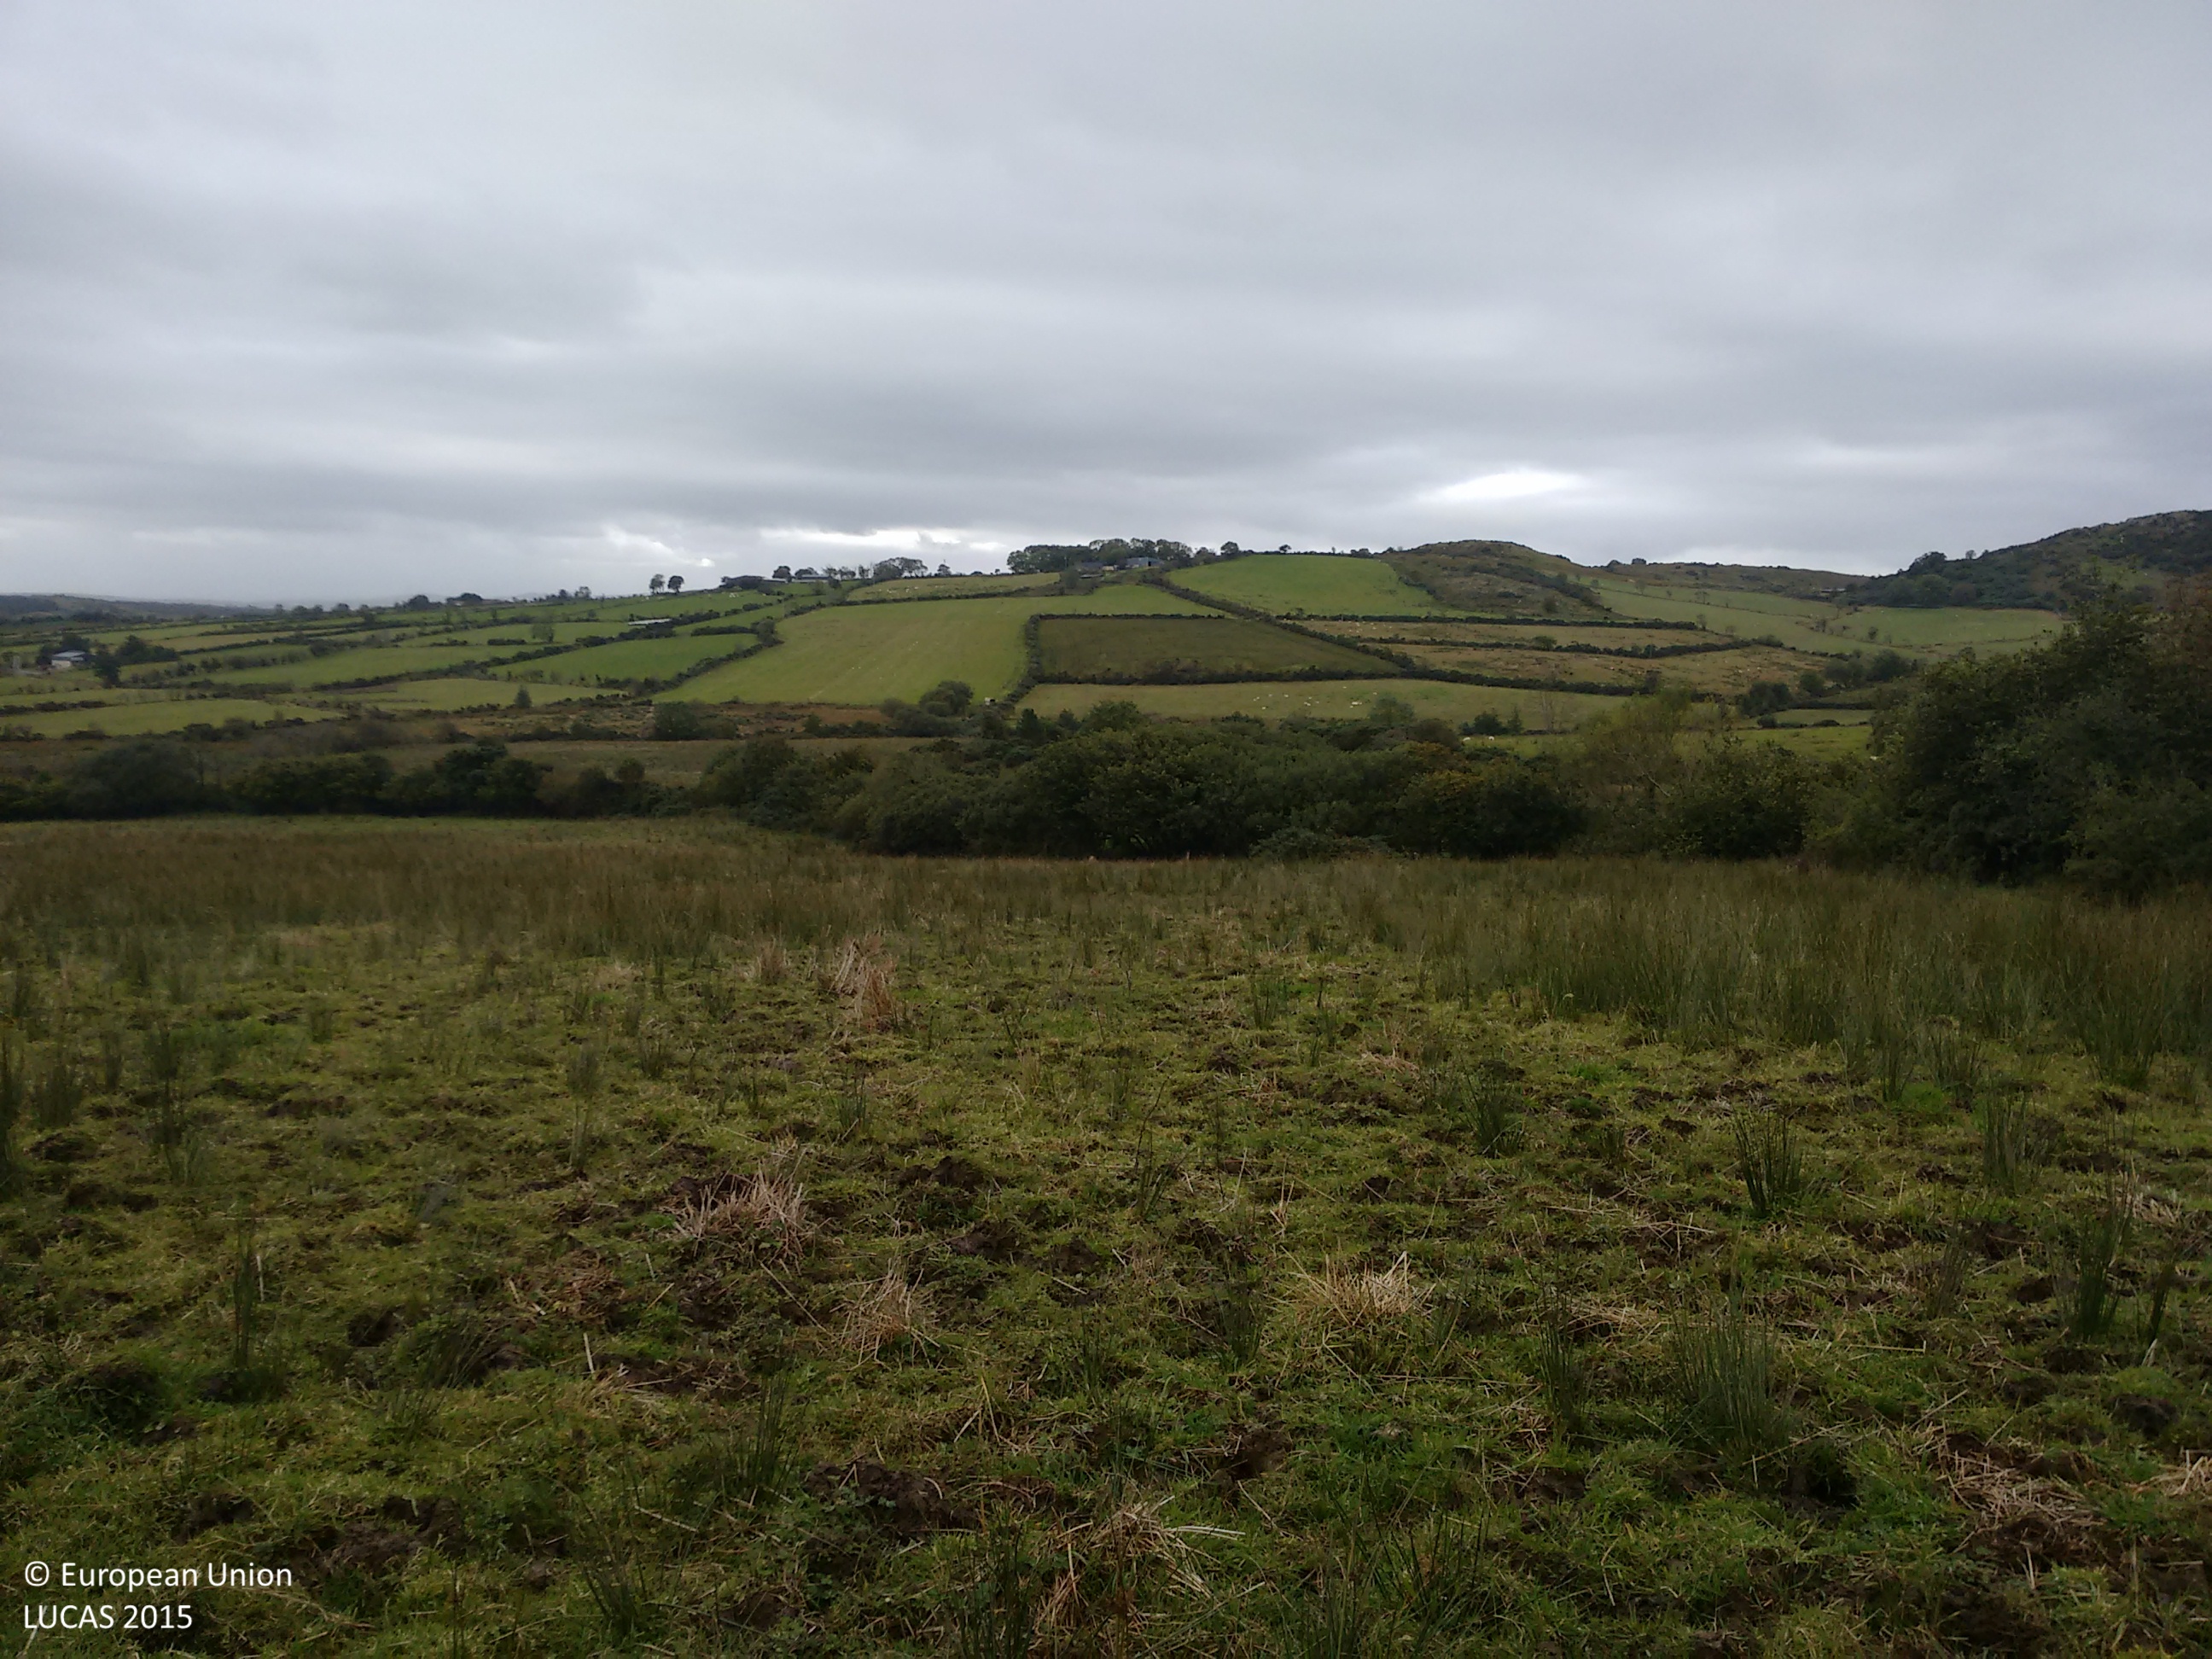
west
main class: Grassland
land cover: Grassland without tree/shrub cover
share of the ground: > 75 %
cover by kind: herbaceous plants 100 %
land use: Agriculture (excluding fallow land and kitchen gardens)
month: September
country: IE
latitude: 55.0775
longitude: -7.6548
